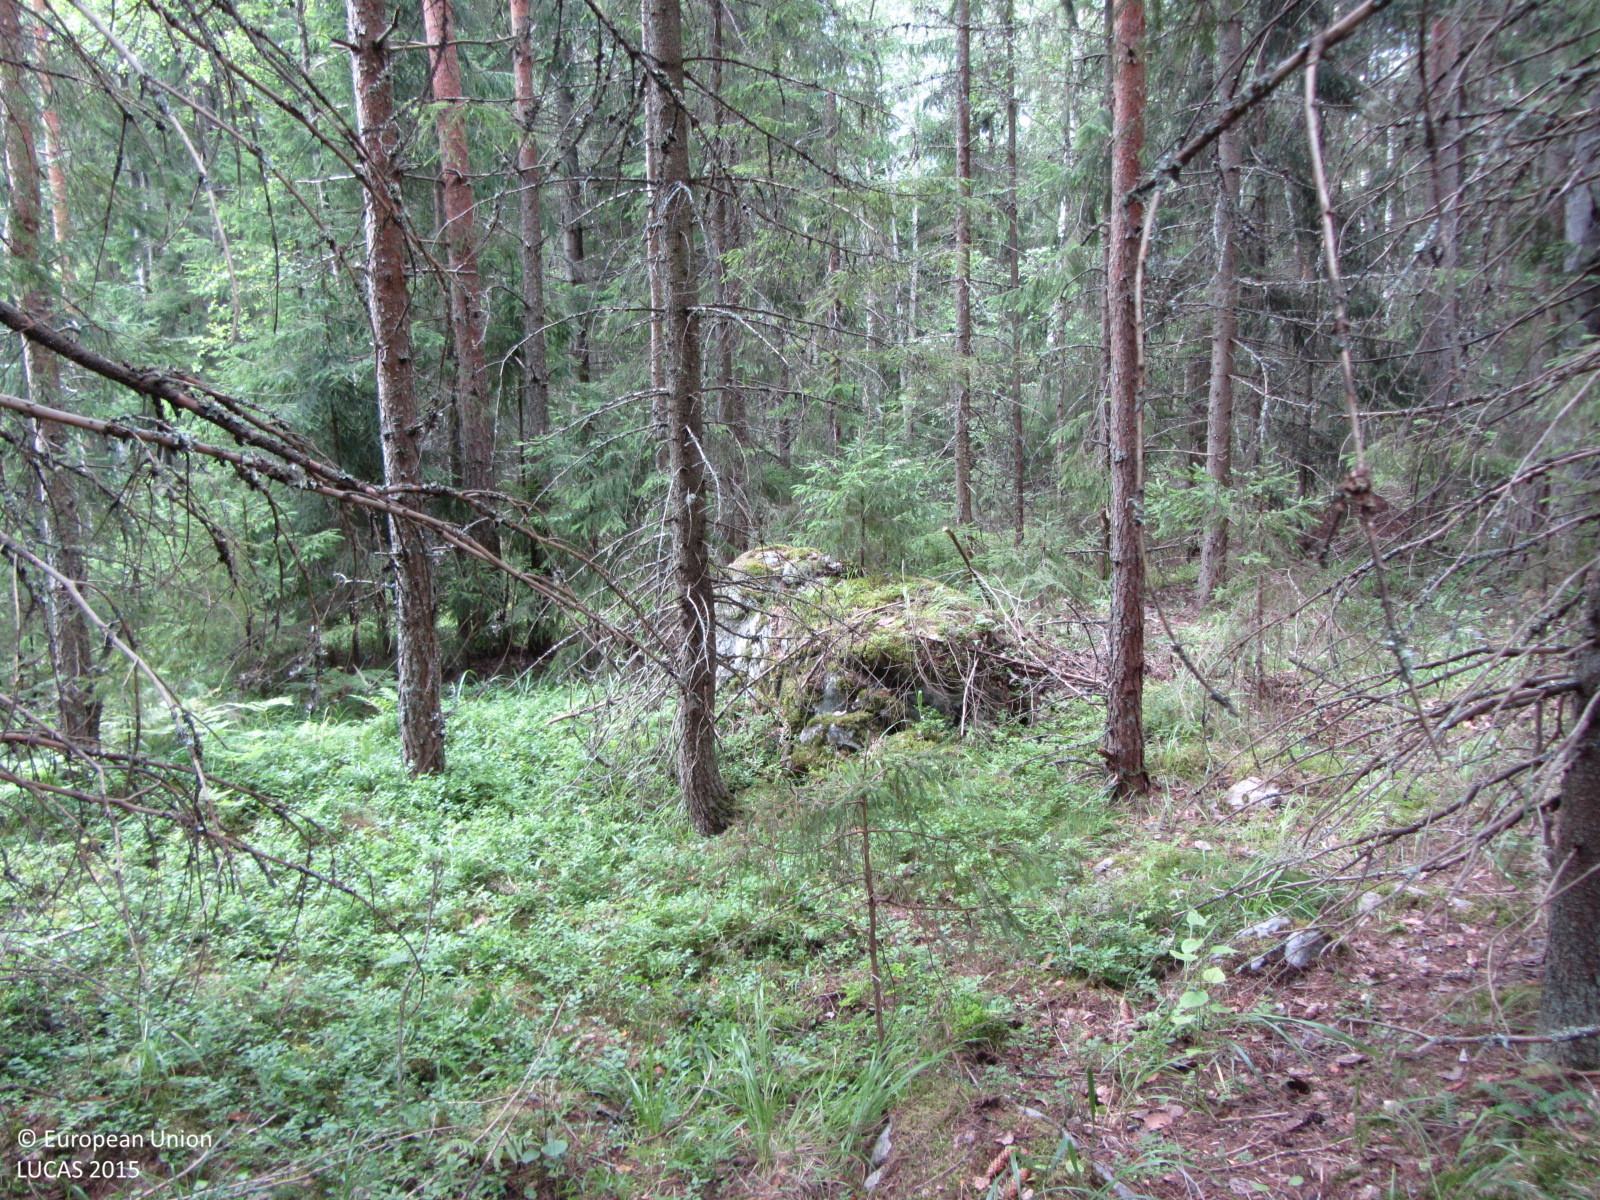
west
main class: Woodland
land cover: Spruce dominated coniferous woodland
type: boreal forest
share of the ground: > 75 %
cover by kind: coniferous forest trees 65 %, broadleaved forest trees 10 %, shrubs 10 %, herbaceous plants 5 %, lichens and mosses 5 %, consolidated bare surface 5 %
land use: Forestry
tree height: > 5 m
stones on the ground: 10 - 25 %
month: July
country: FI
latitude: 60.6341
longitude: 24.5297
